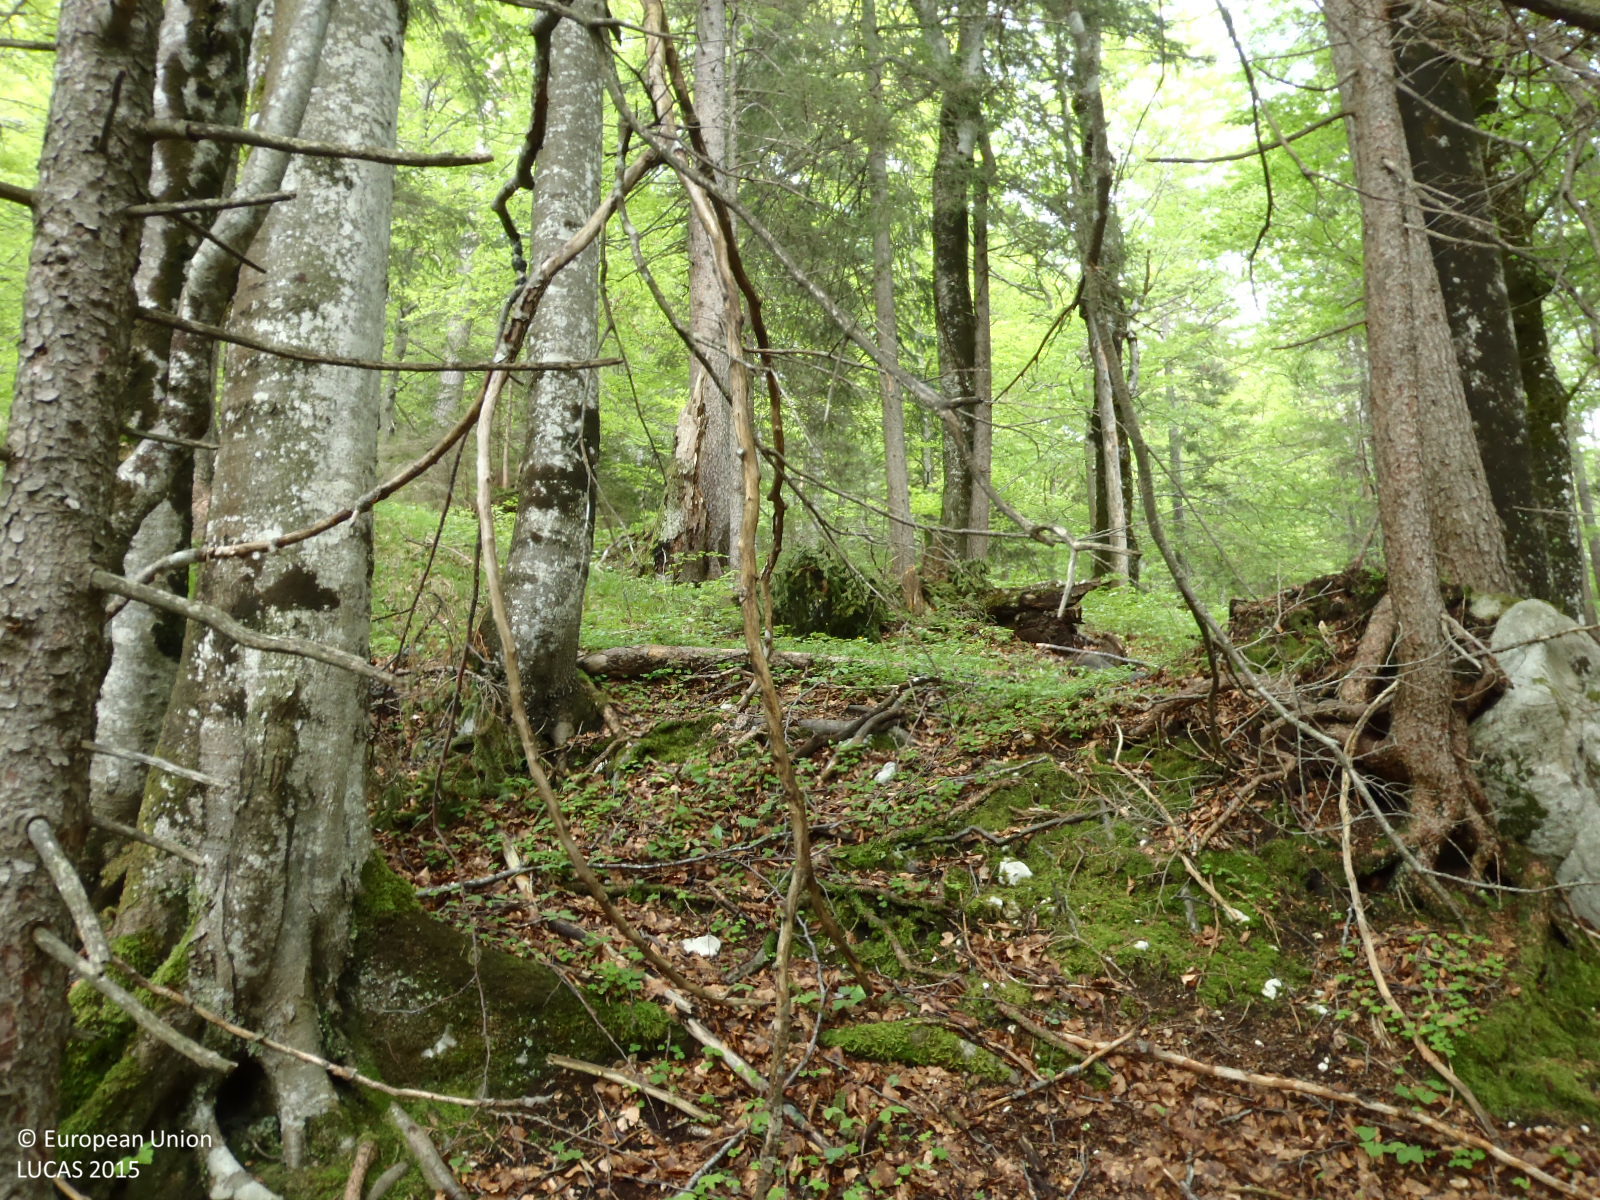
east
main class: Woodland
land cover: Spruce dominated mixed woodland
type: mountainous beech forest
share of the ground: > 75 %
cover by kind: broadleaved forest trees 55 %, coniferous forest trees 45 %
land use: Forestry
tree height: > 5 m
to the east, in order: Spruce dominated mixed woodland; Rivers and streams; Other mixed woodland; Spruce dominated mixed woodland
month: May
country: AT
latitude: 47.5249
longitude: 11.7916
